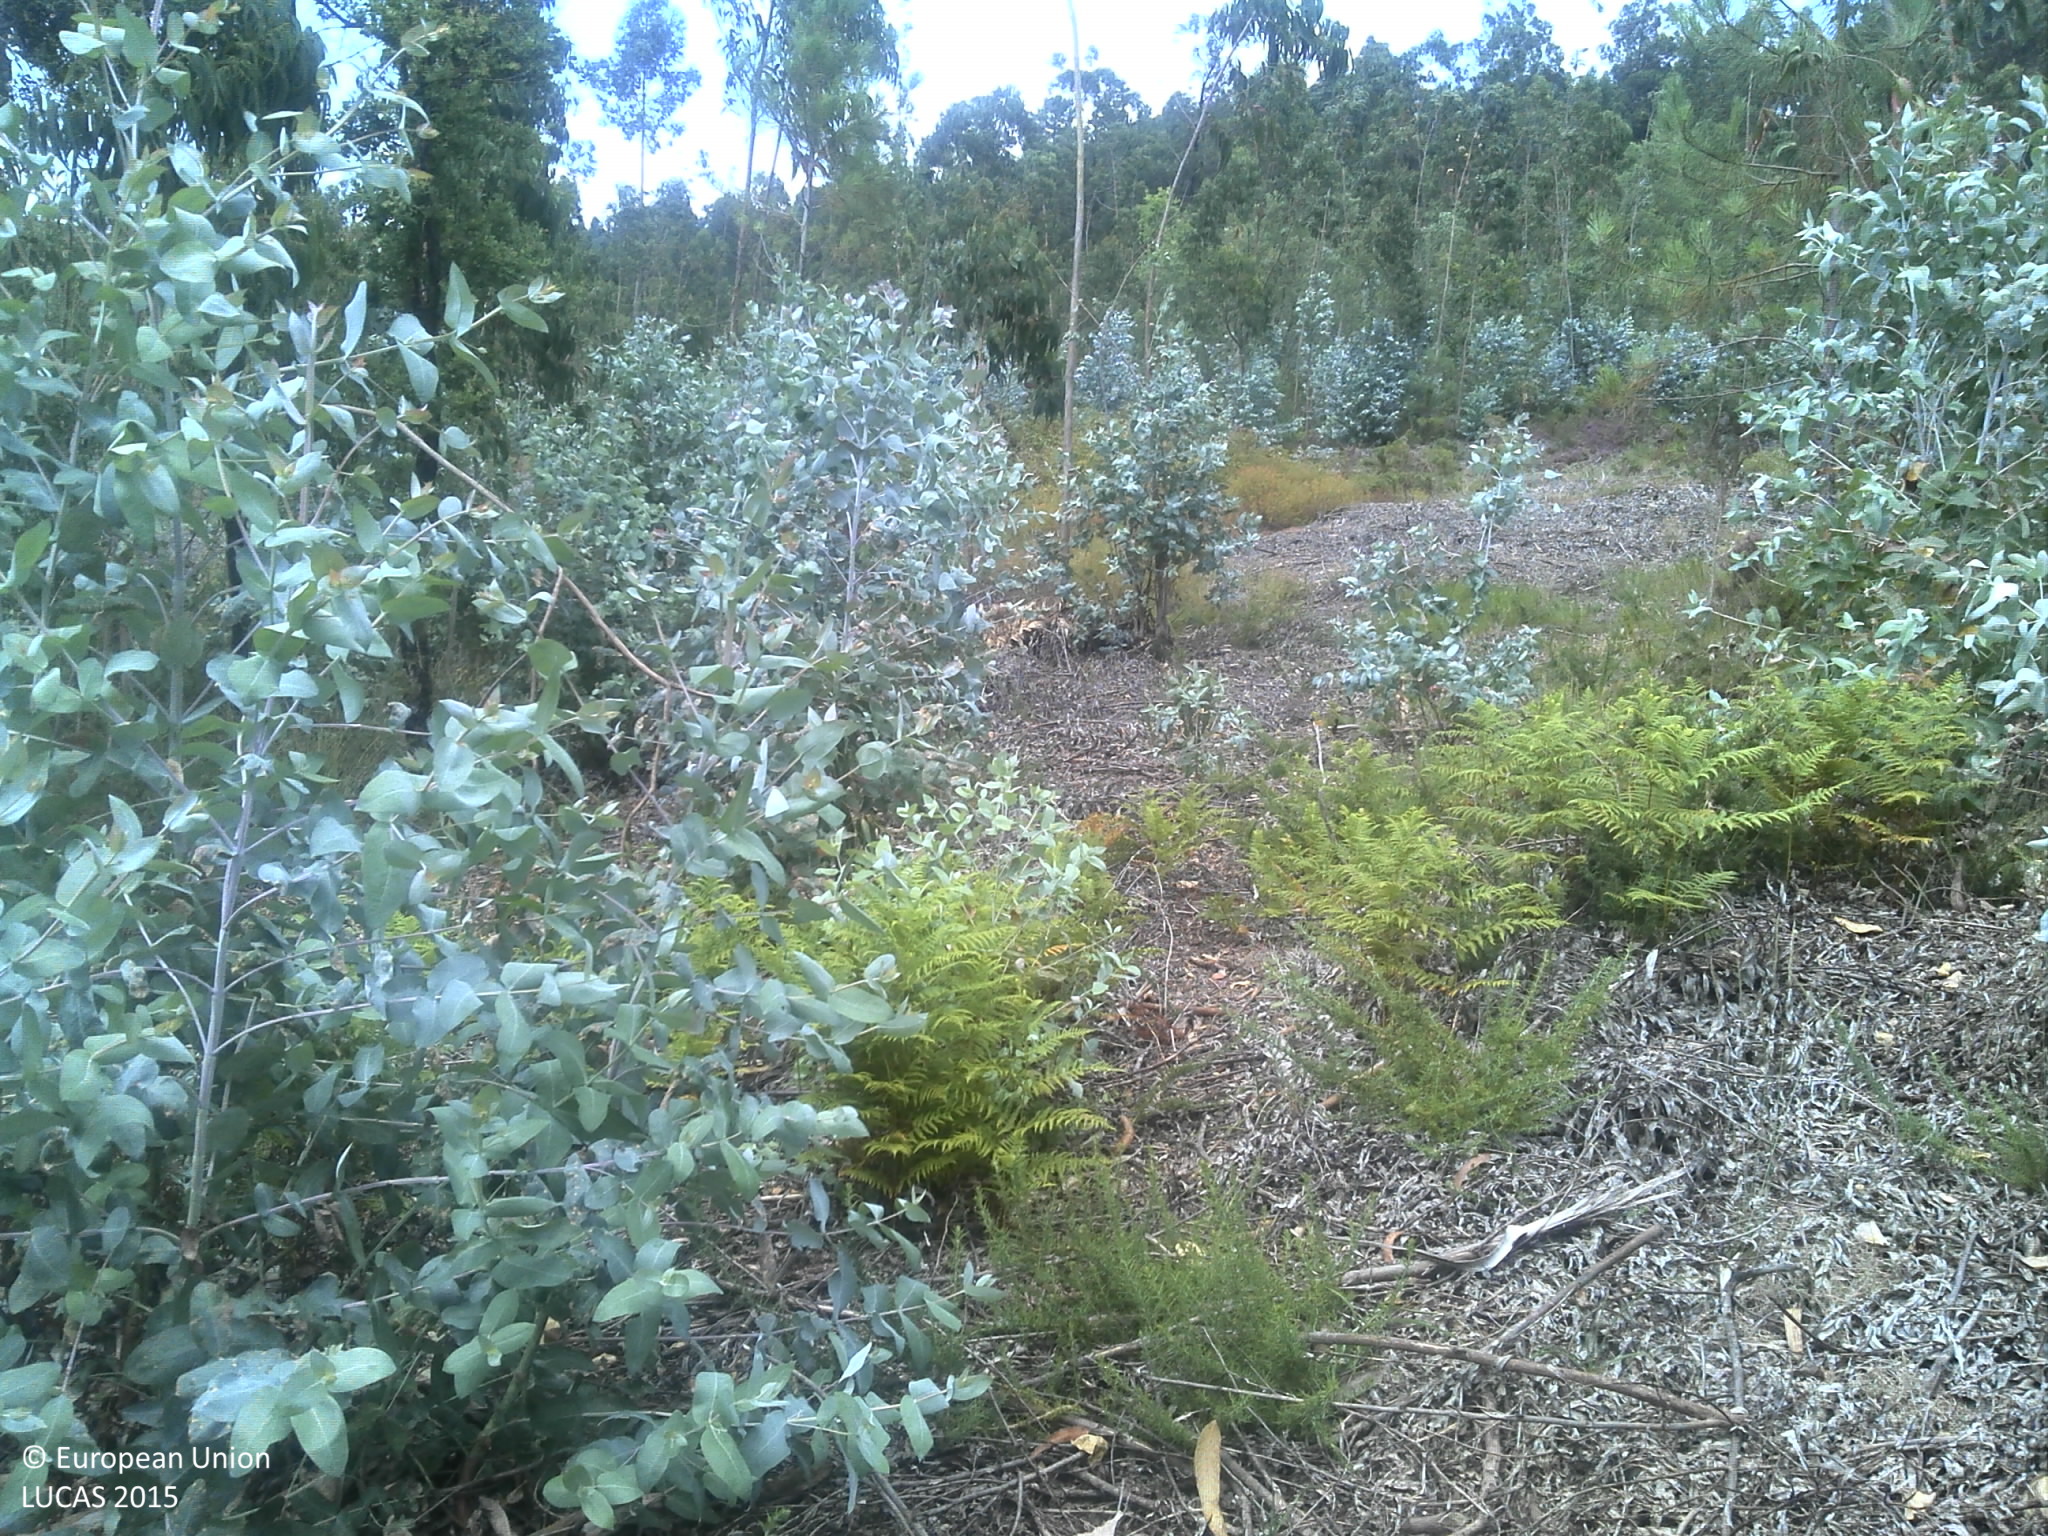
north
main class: Woodland
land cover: Broadleaved woodland
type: exotic forest
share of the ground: 25 - 50 %
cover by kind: broadleaved forest trees 50 %, unconsolidated bare surface 40 %, shrubs 10 %
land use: Forestry
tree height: < 5 m
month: June
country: PT
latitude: 41.5666
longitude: -8.5657
